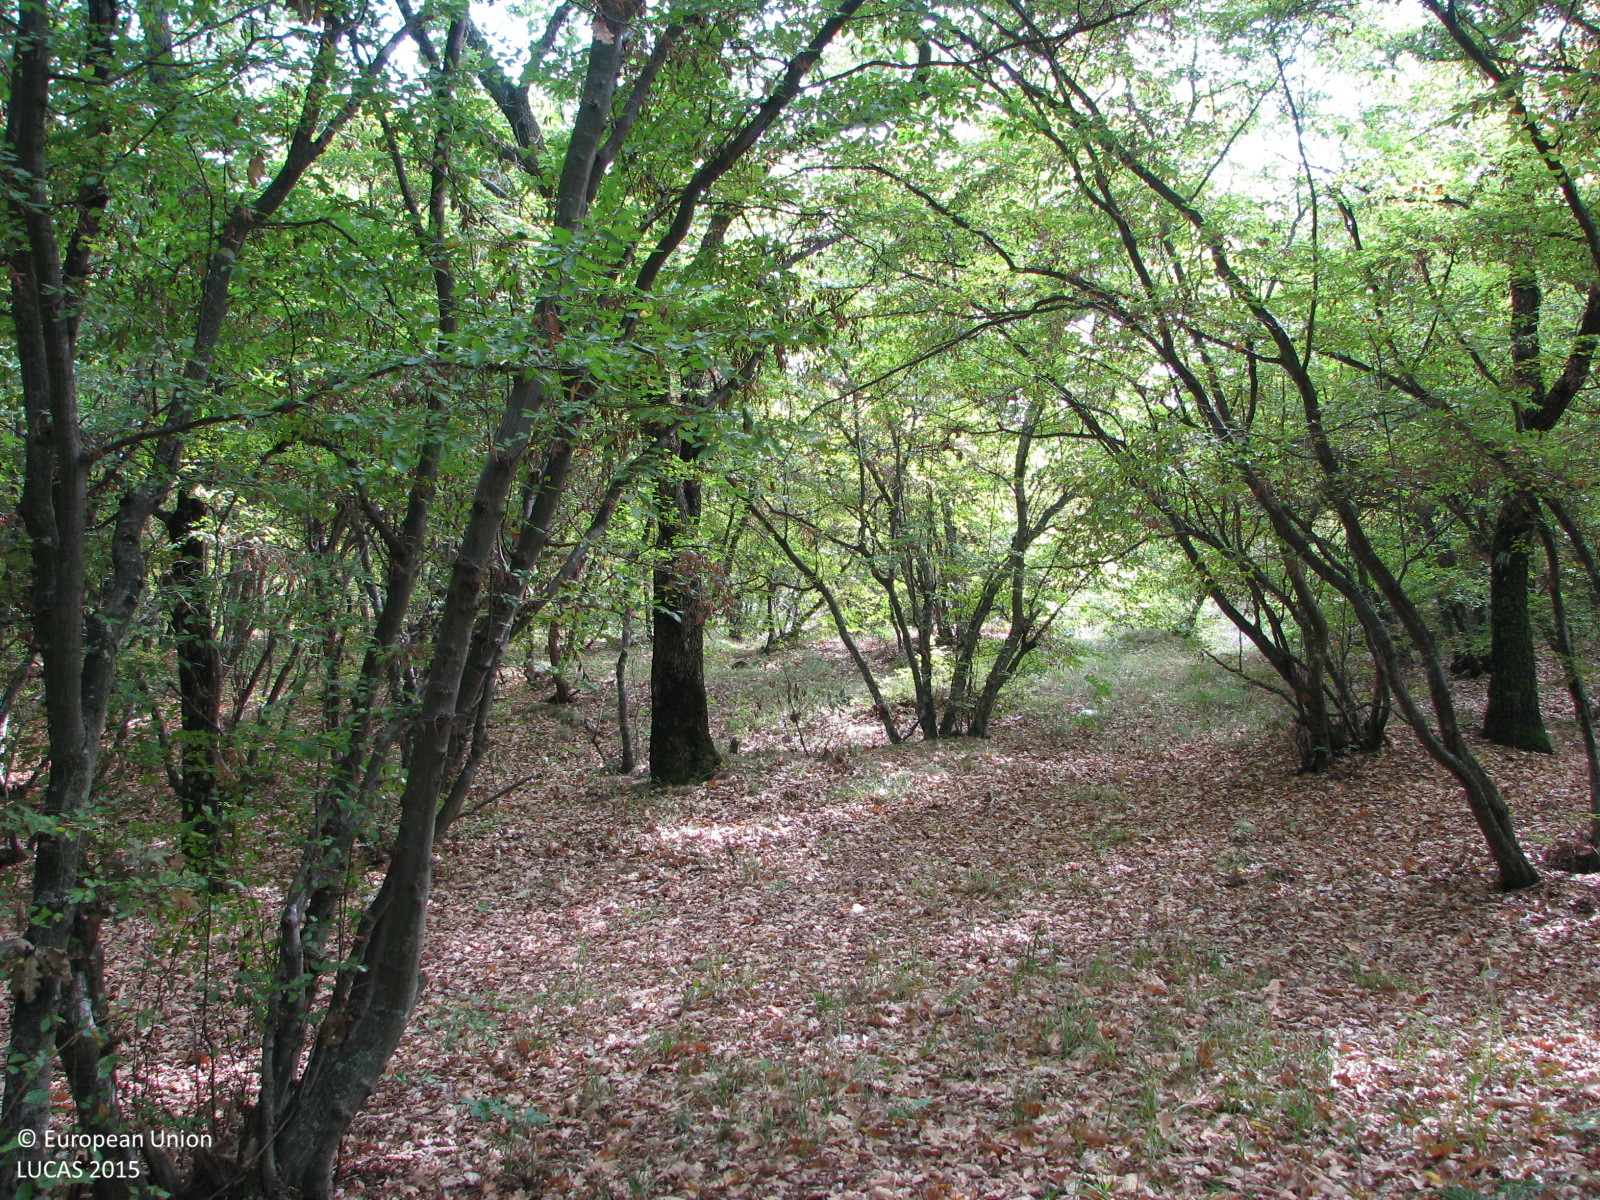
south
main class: Woodland
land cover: Broadleaved woodland
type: mesophytic deciduous forest
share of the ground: 50 - 75 %
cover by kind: broadleaved forest trees 70 %, unconsolidated bare surface 30 %
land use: Forestry
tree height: > 5 m
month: October
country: BG
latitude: 42.5425
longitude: 25.9216
